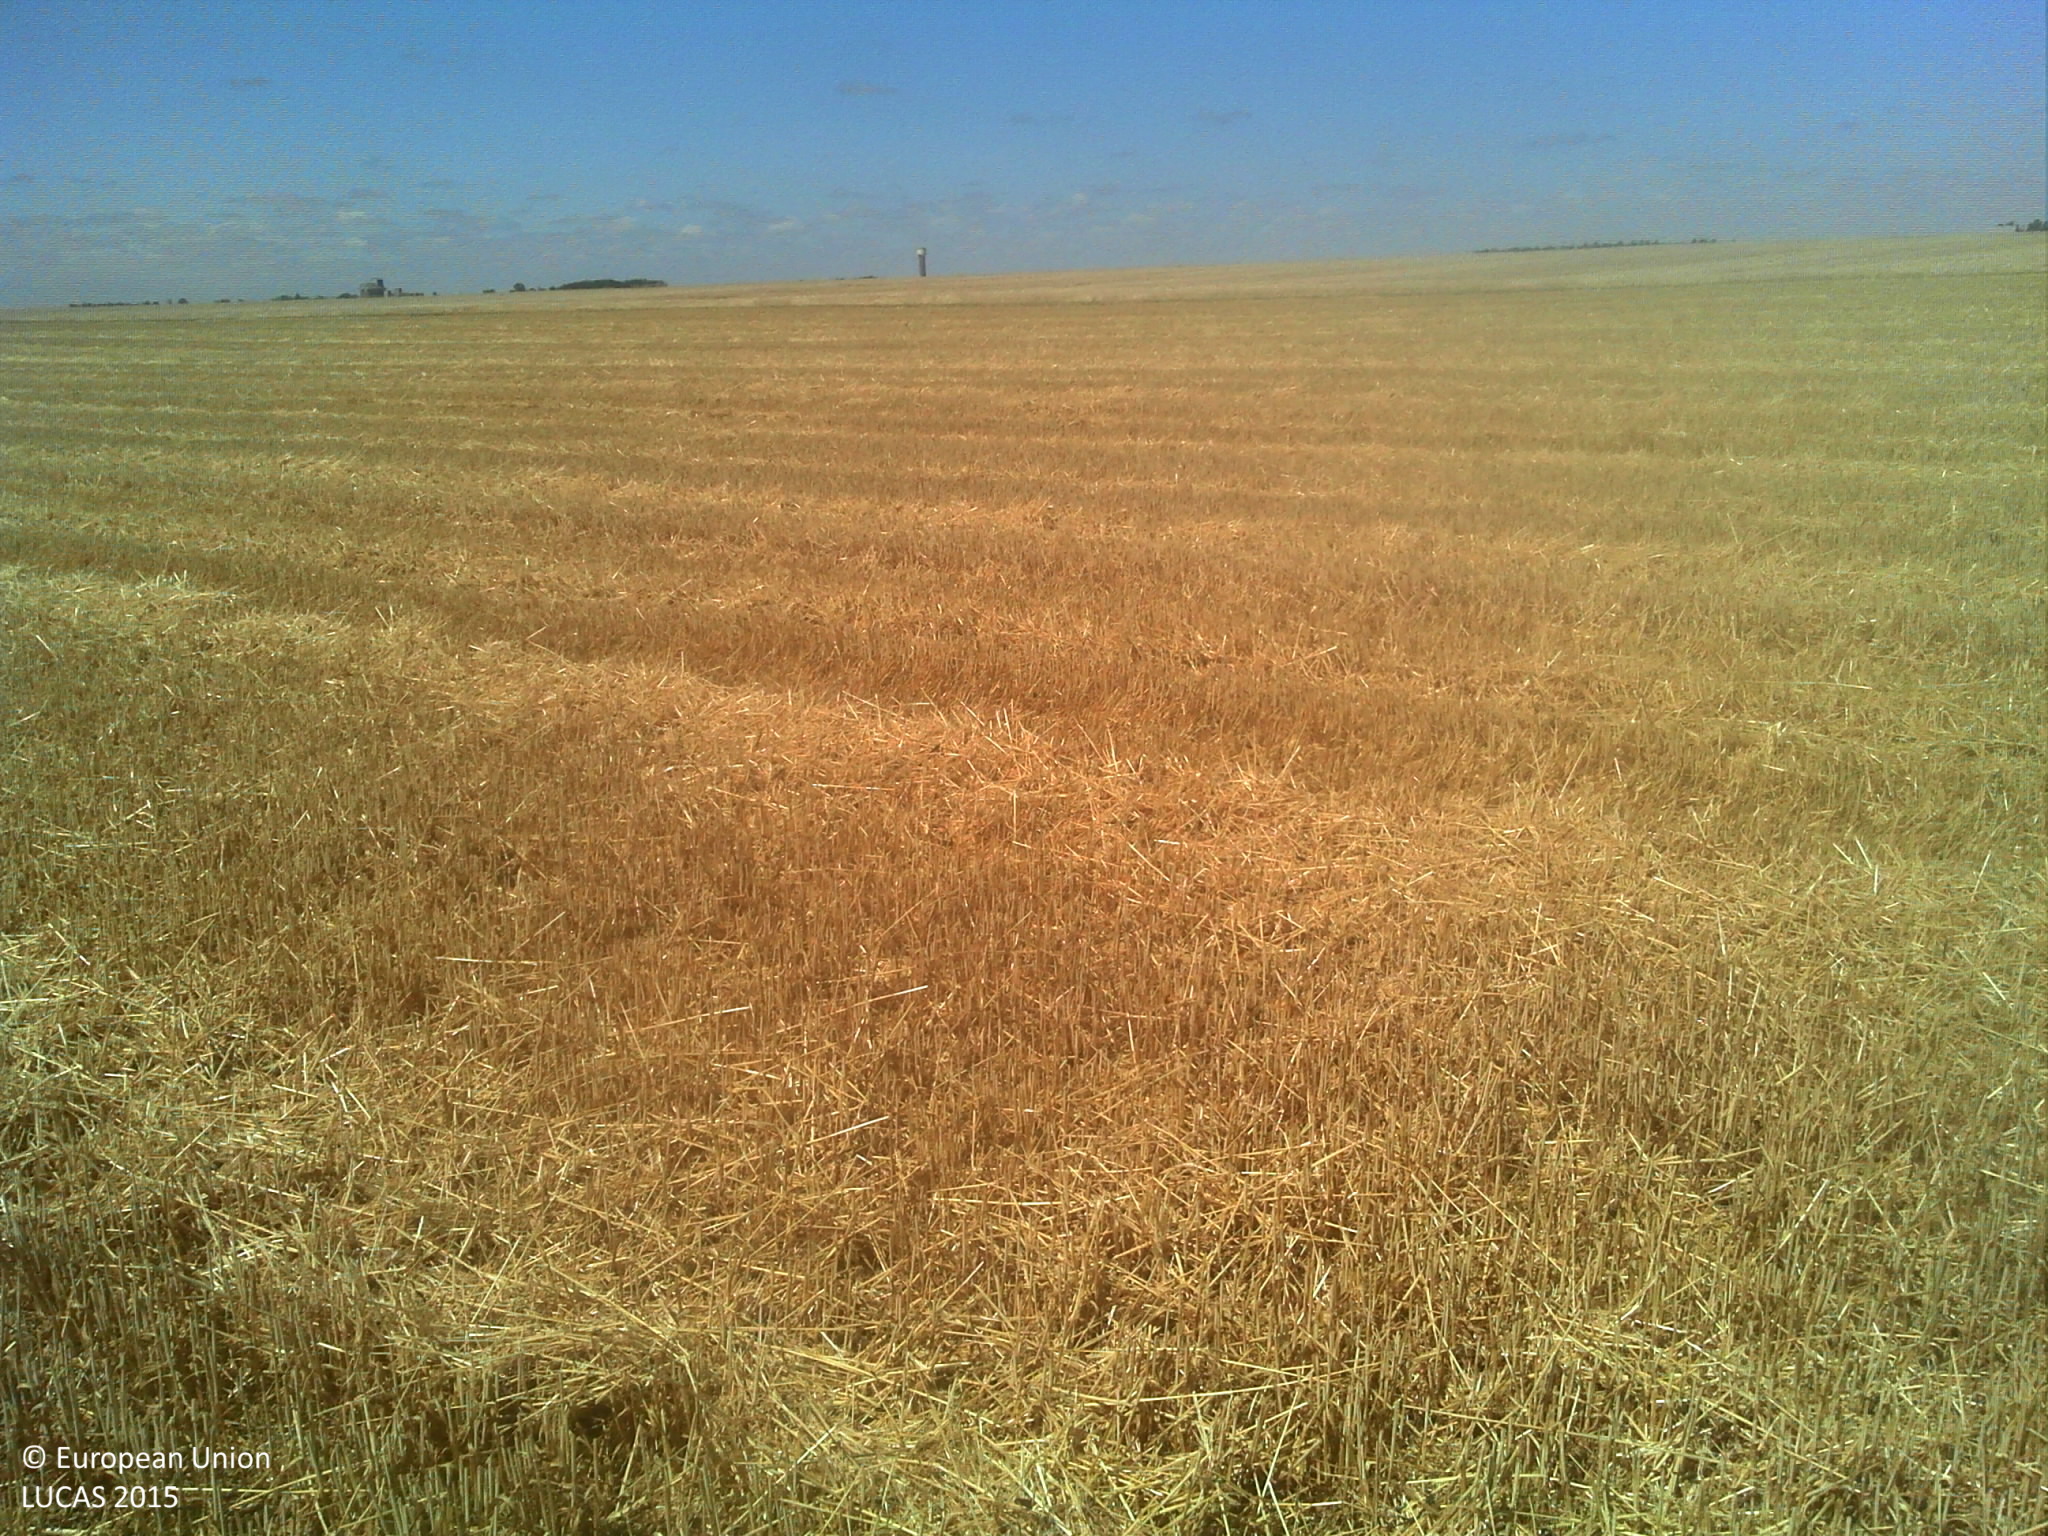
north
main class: Cropland
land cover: Durum wheat
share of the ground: > 75 %
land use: Agriculture (excluding fallow land and kitchen gardens)
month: July
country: FR
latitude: 47.9194
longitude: 1.3524
